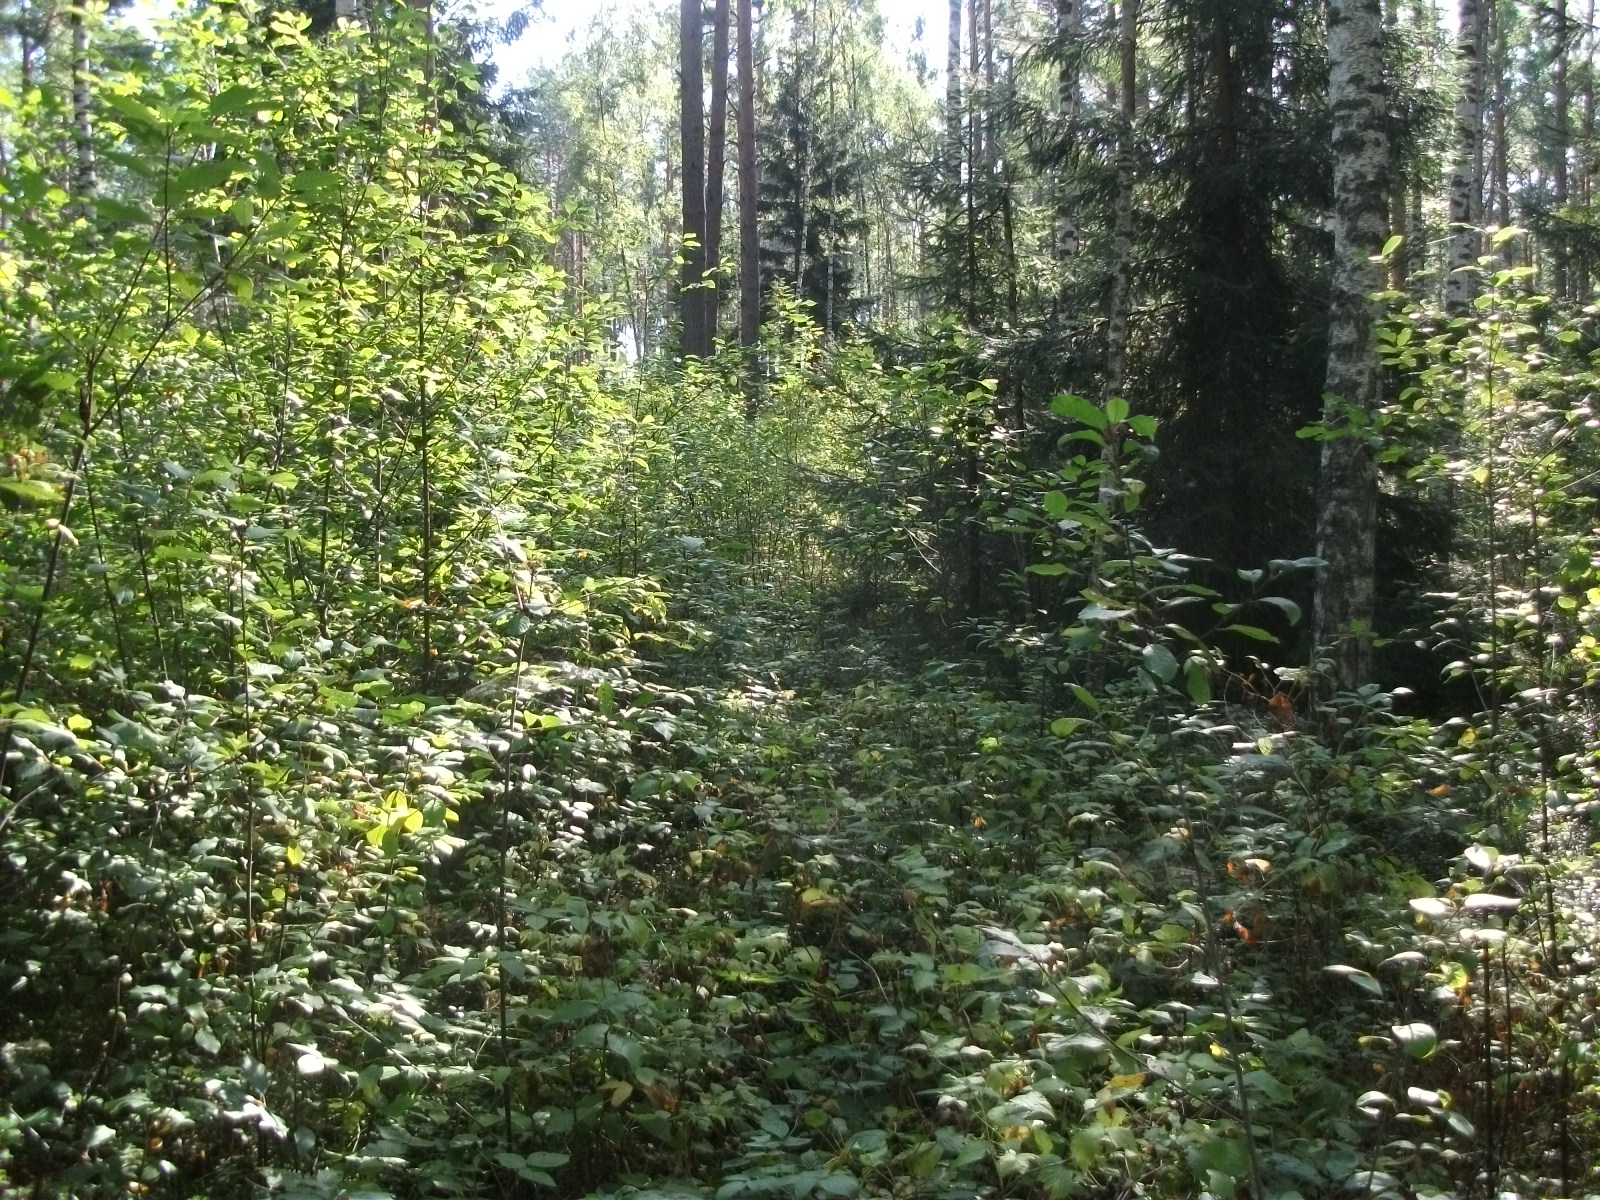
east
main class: Woodland
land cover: Pine dominated mixed woodland
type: hemiboreal forest and nemoral coniferous forest and mixed broadleaved-coniferous forest
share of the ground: > 75 %
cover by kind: coniferous forest trees 55 %, broadleaved forest trees 30 %, shrubs 10 %, herbaceous plants 5 %
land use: Forestry
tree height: > 5 m
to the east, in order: Pine dominated mixed woodland; Broadleaved woodland; Grass margins; Tracks; Grassland with sparse tree/shrub cover
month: August
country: LV
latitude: 56.4070
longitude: 26.1327
